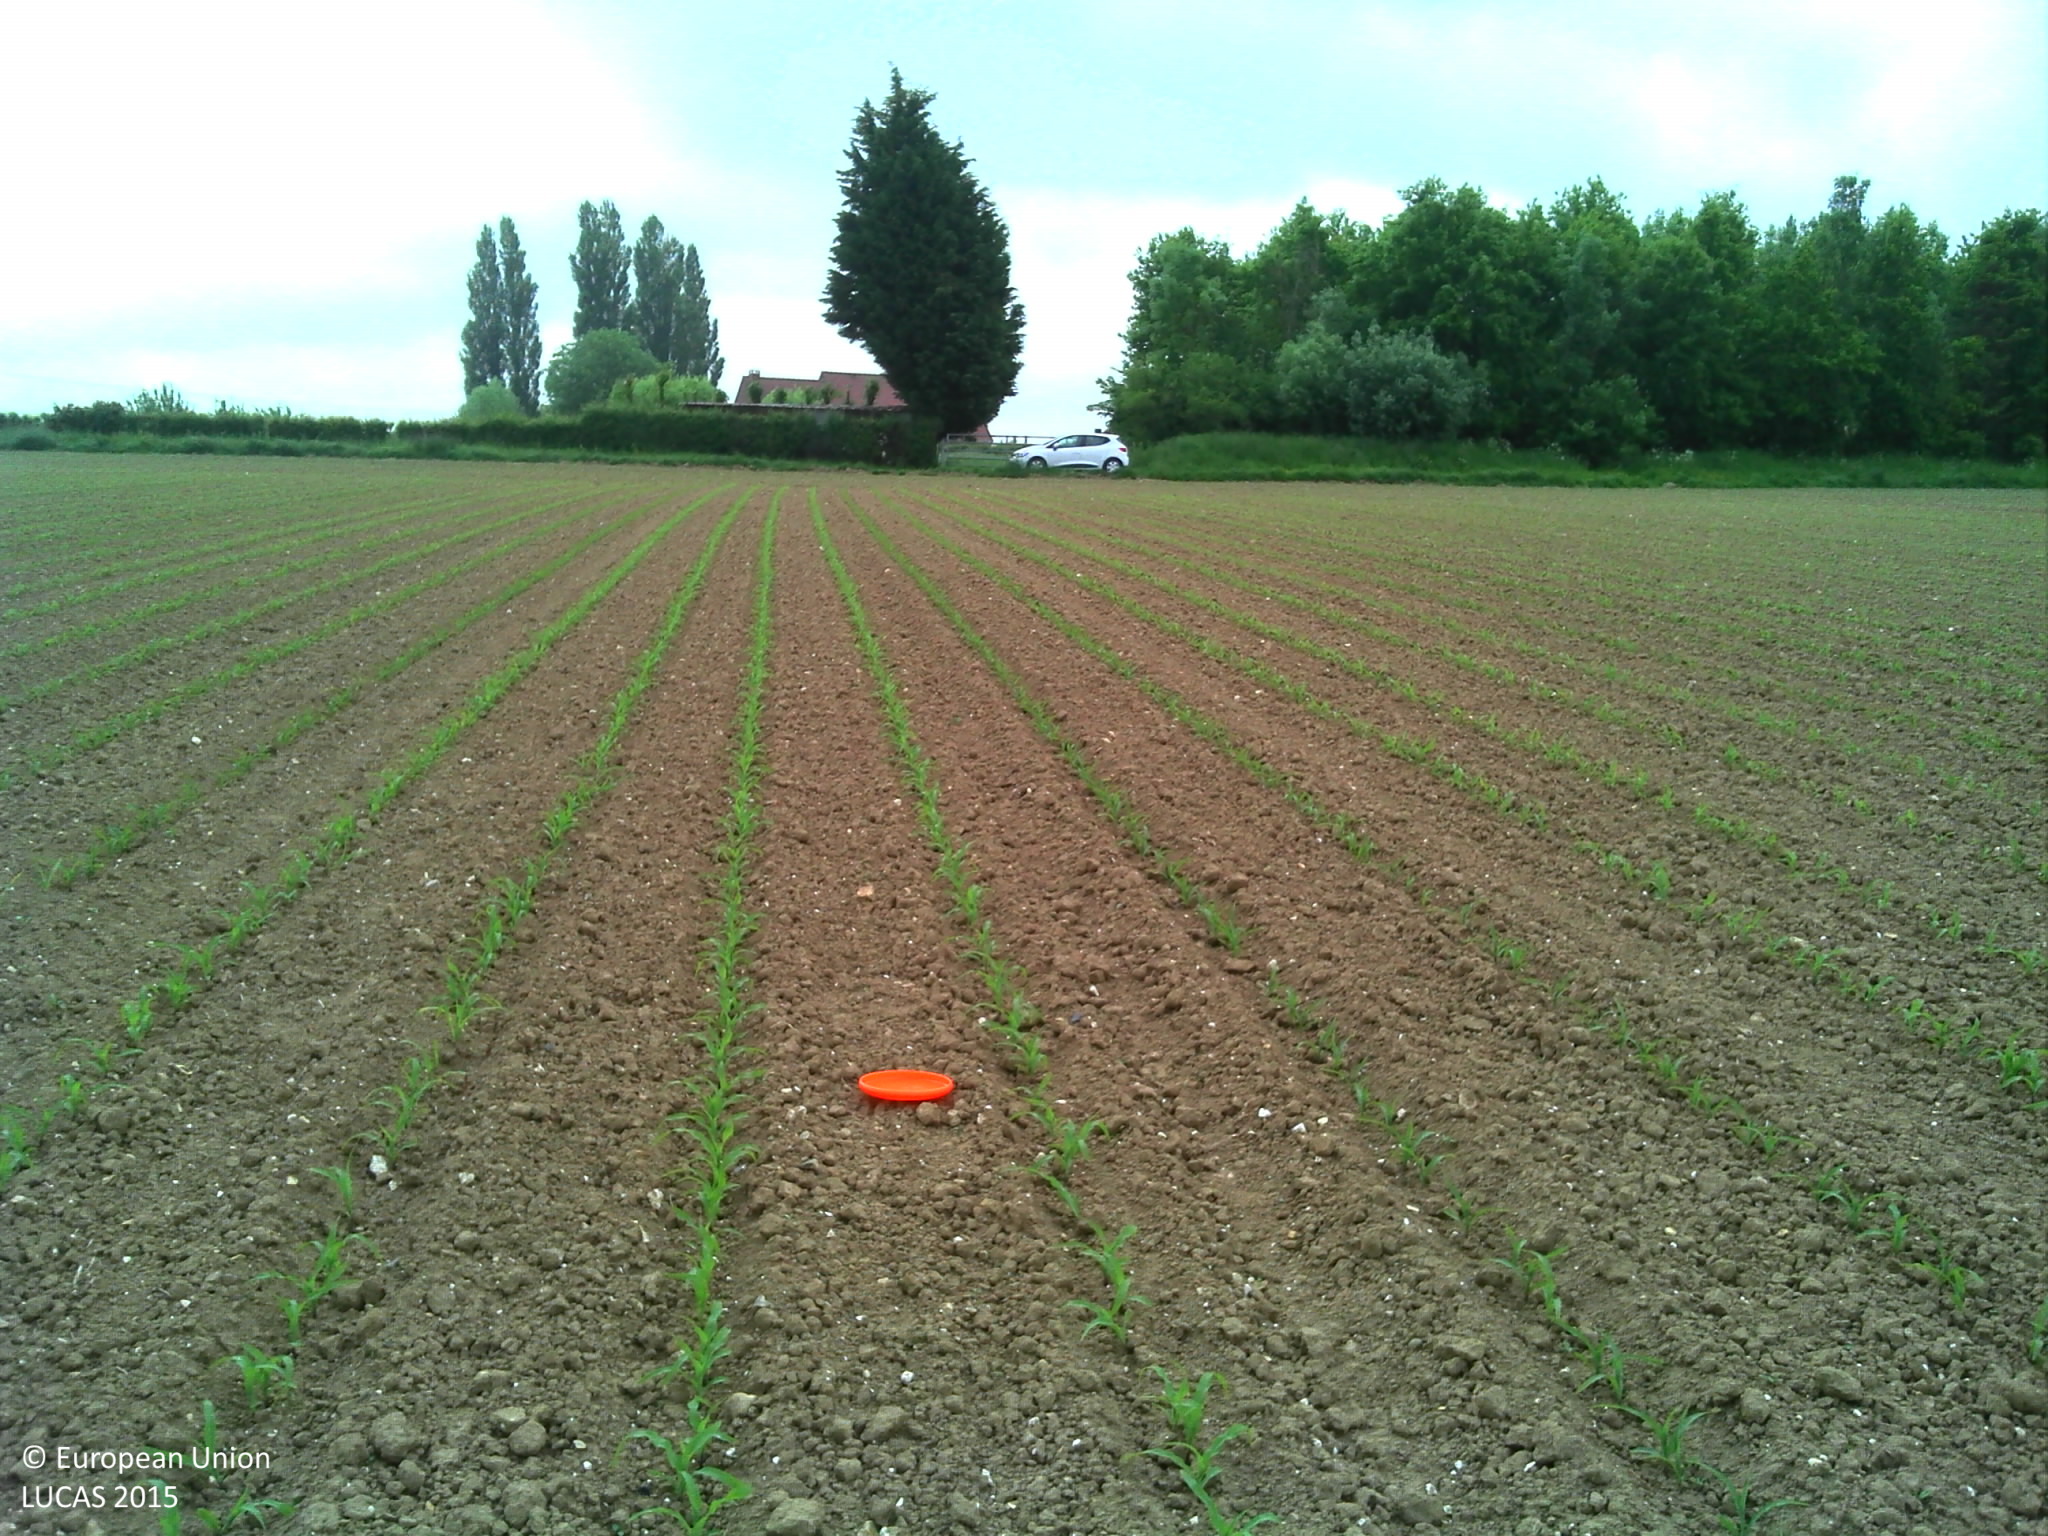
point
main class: Cropland
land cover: Maize
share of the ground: 10 - 25 %
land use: Agriculture (excluding fallow land and kitchen gardens)
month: May
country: FR
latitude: 50.6486
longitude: 2.3350
